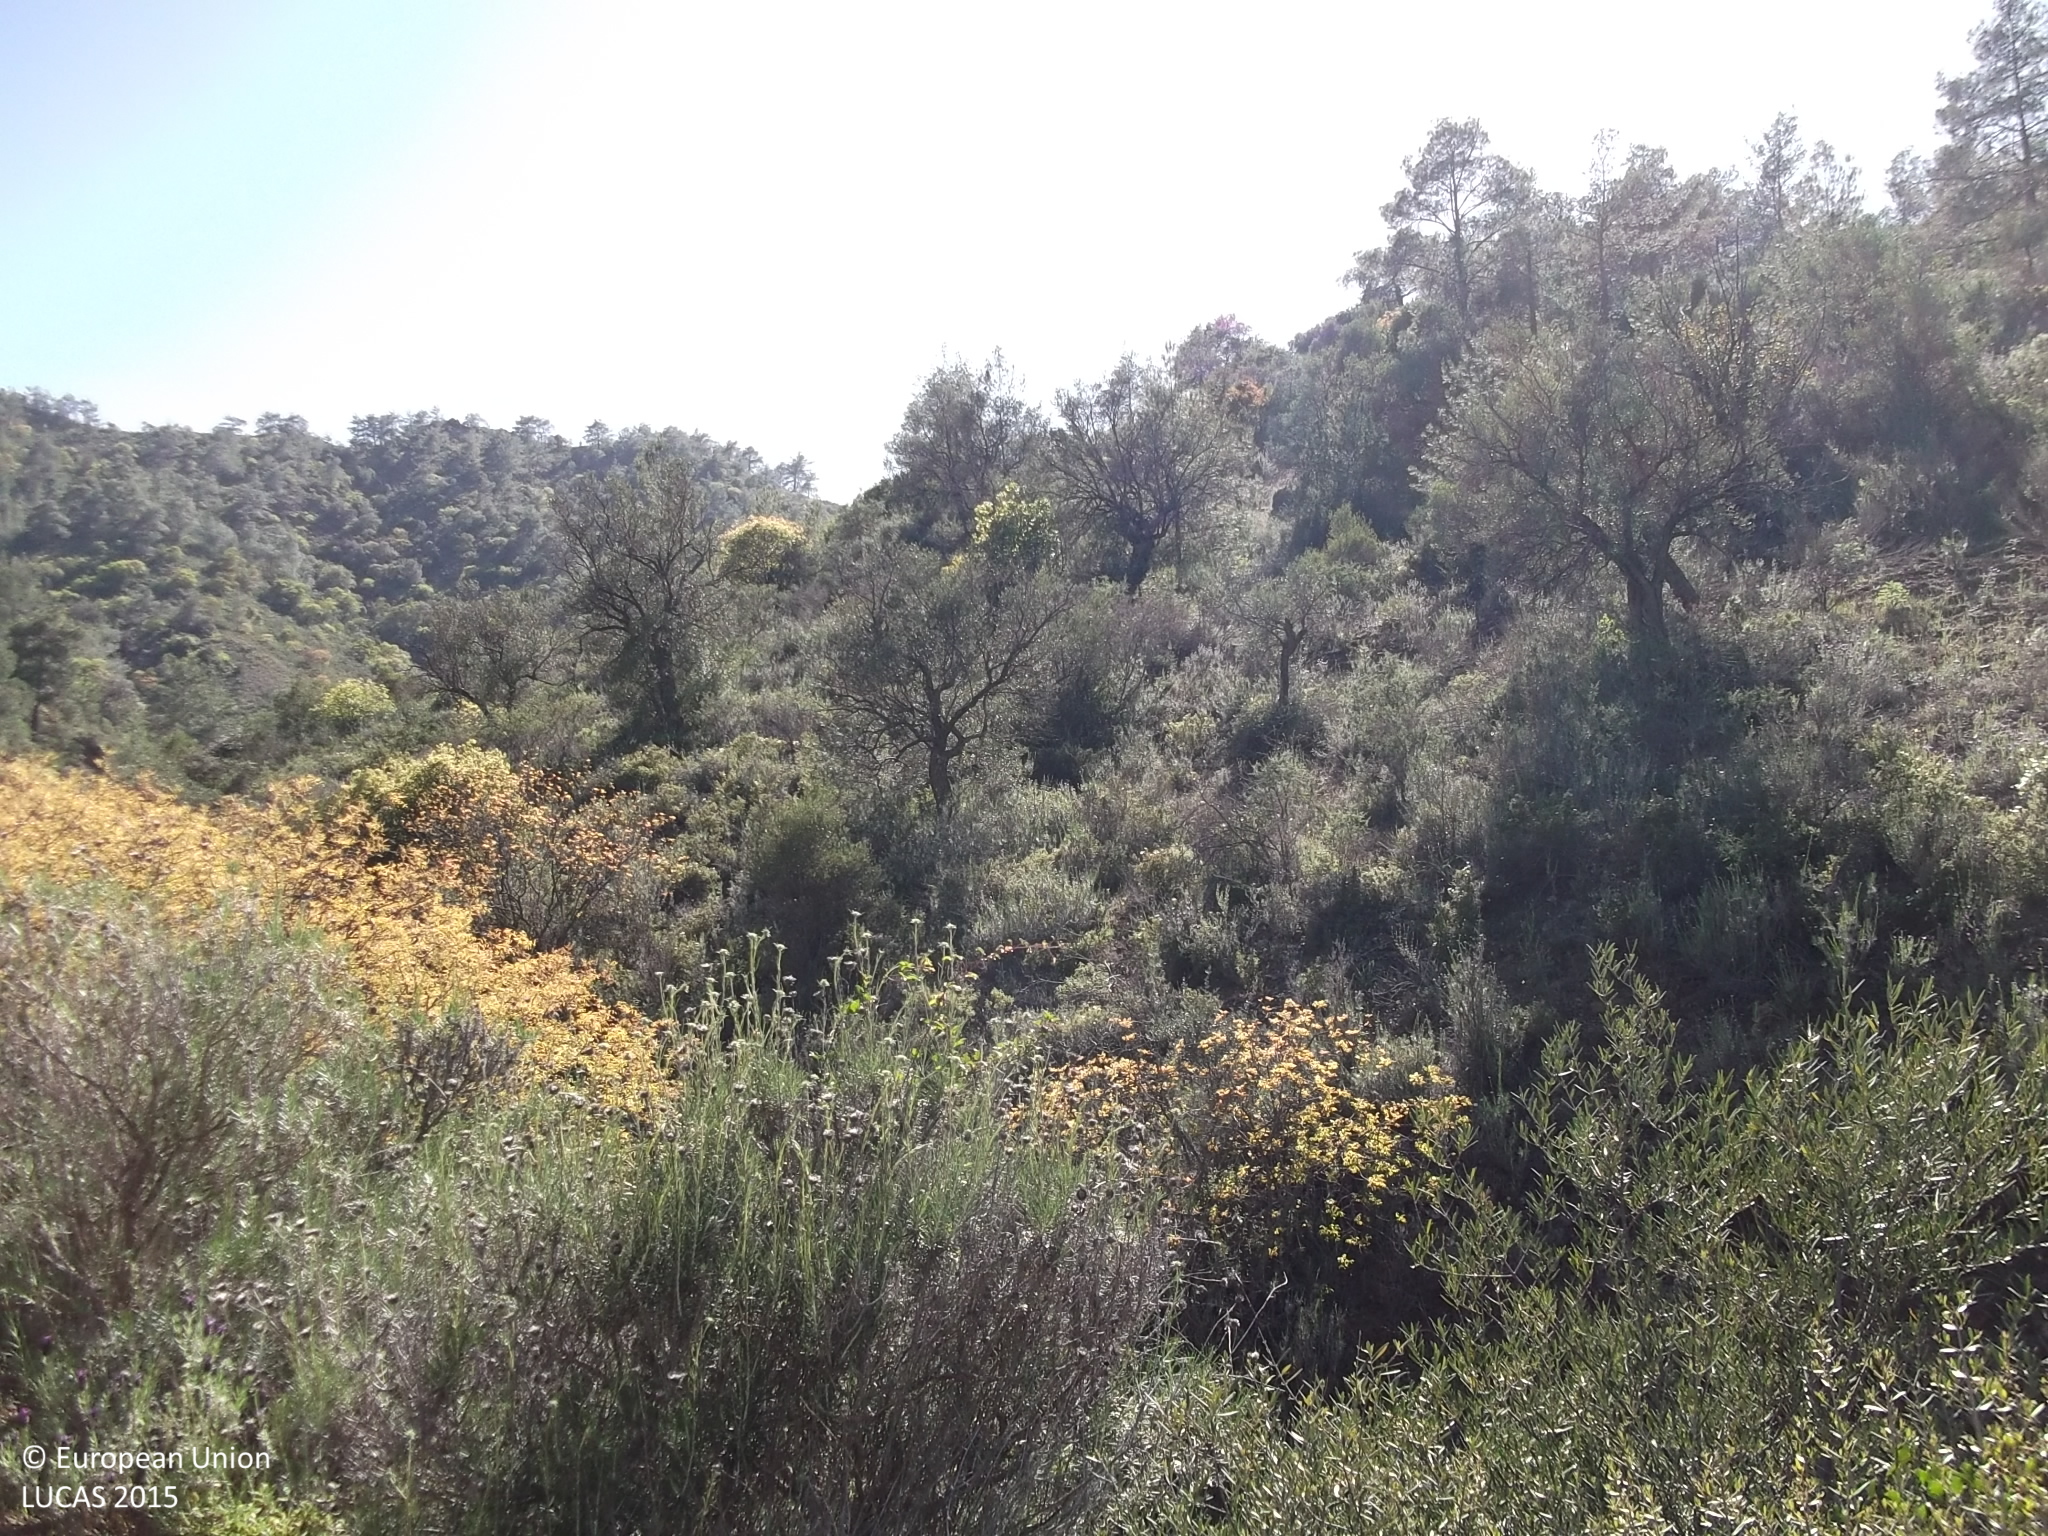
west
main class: Woodland
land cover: Pine dominated coniferous woodland
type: coniferous forest of the mediterranean region
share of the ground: > 75 %
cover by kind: coniferous forest trees 95 %, broadleaved forest trees 5 %
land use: Semi-natural and natural areas not in use
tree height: > 5 m
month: April
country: CY
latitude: 34.8594
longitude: 33.1106
